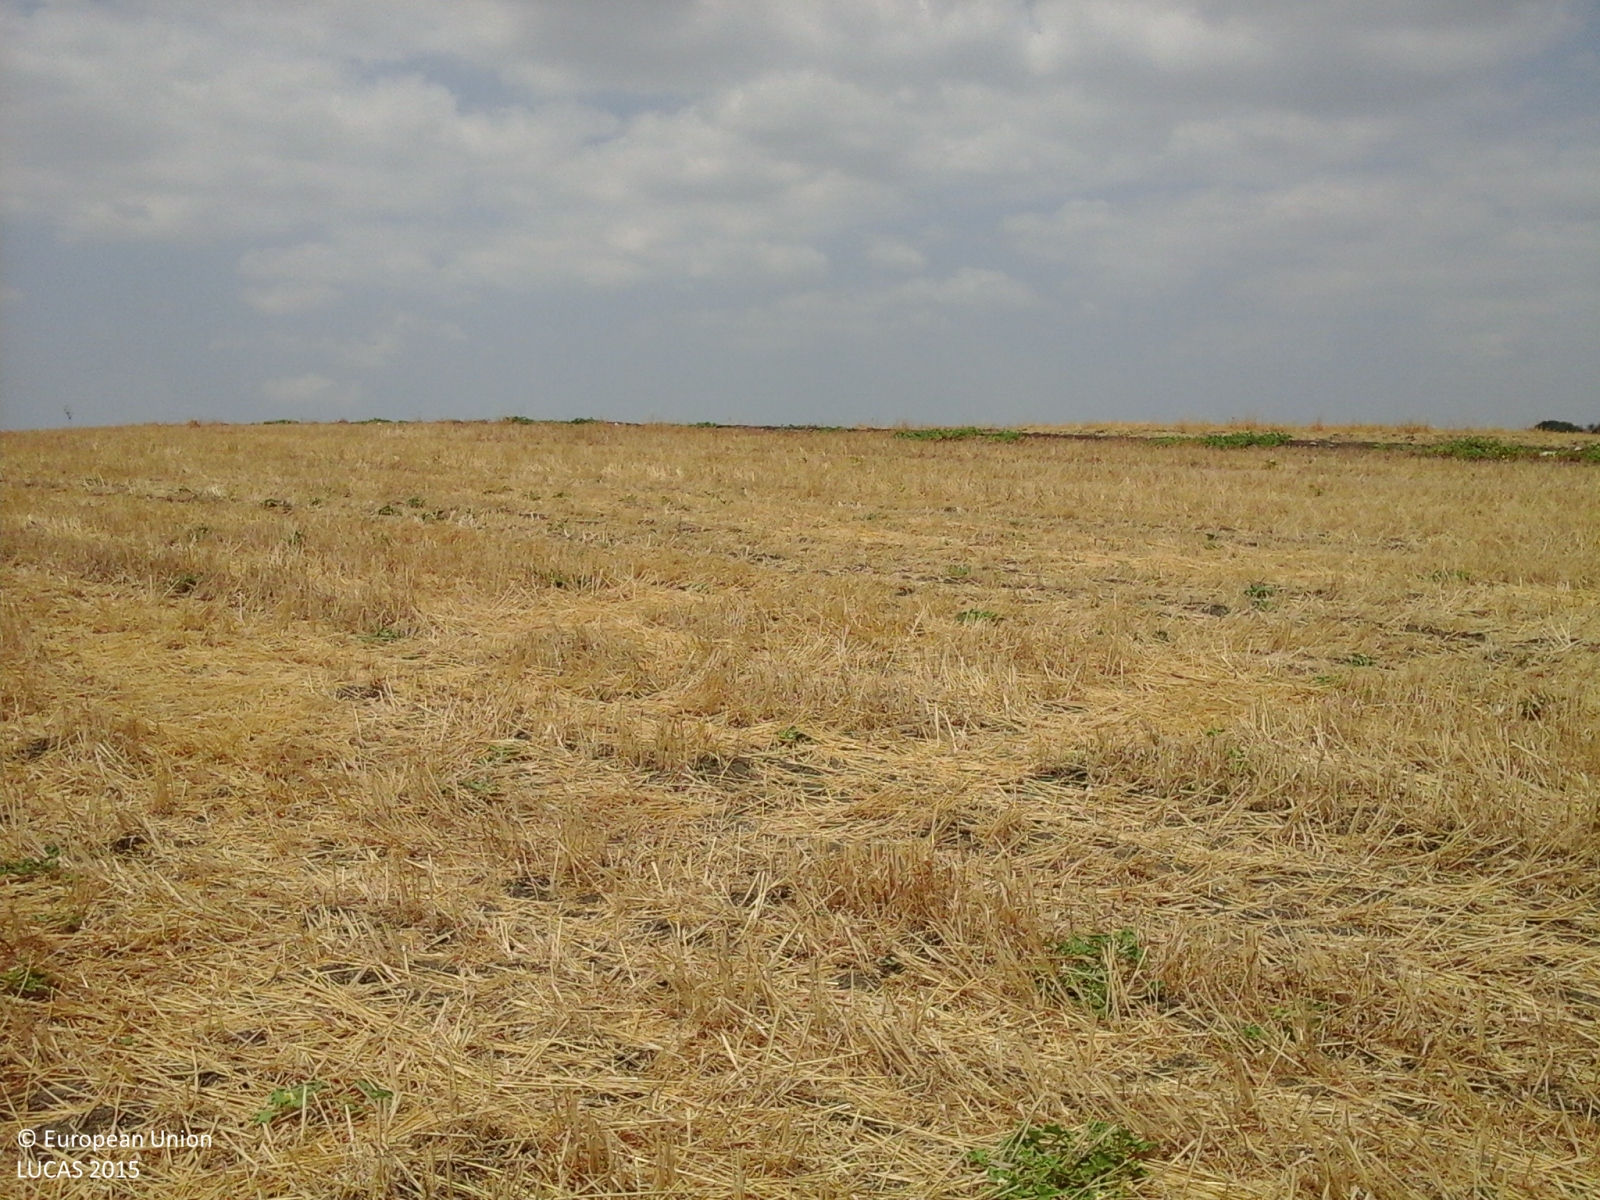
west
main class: Cropland
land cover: Durum wheat
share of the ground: > 75 %
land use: Agriculture (excluding fallow land and kitchen gardens)
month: July
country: IT
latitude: 37.2856
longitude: 13.9062
